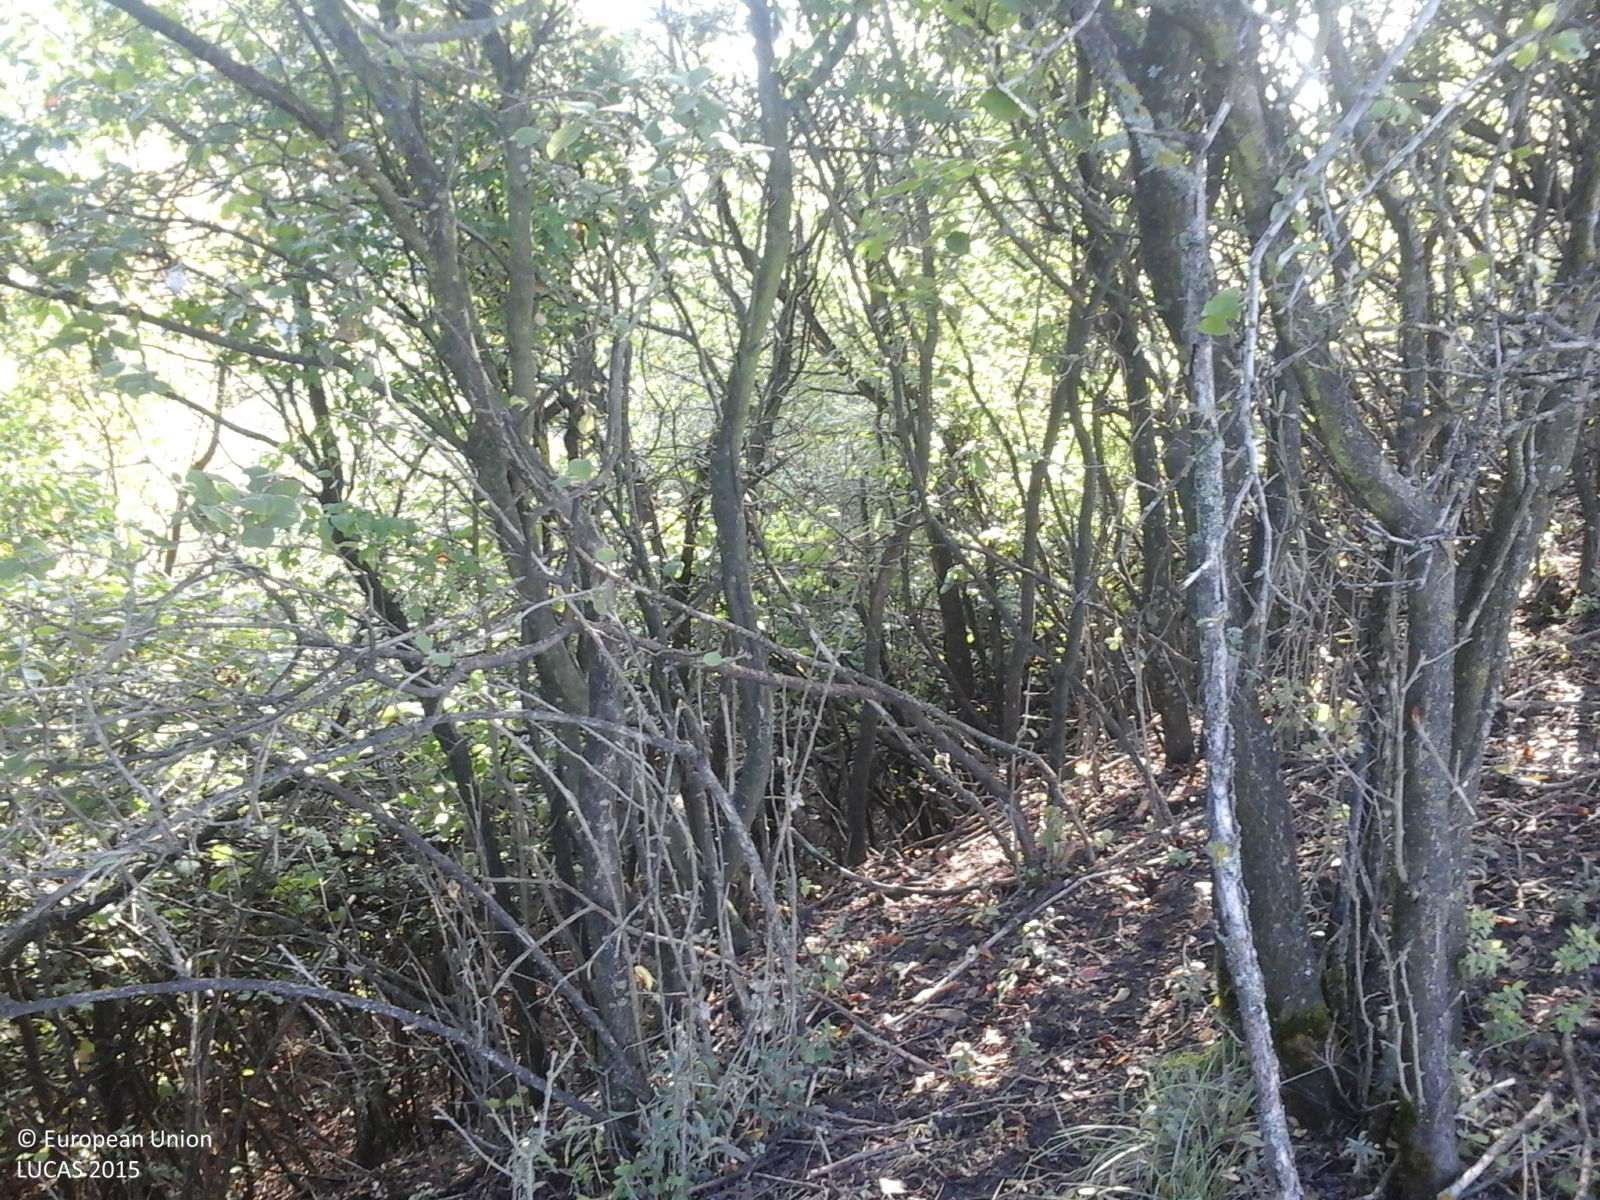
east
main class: Shrubland
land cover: Shrubland without tree cover
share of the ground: > 75 %
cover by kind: shrubs 100 %
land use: Semi-natural and natural areas not in use
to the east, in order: Shrubland without tree cover; Grassland with sparse tree/shrub cover; Tracks; Shrubland without tree cover
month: October
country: RO
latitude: 46.3851
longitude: 23.9227
